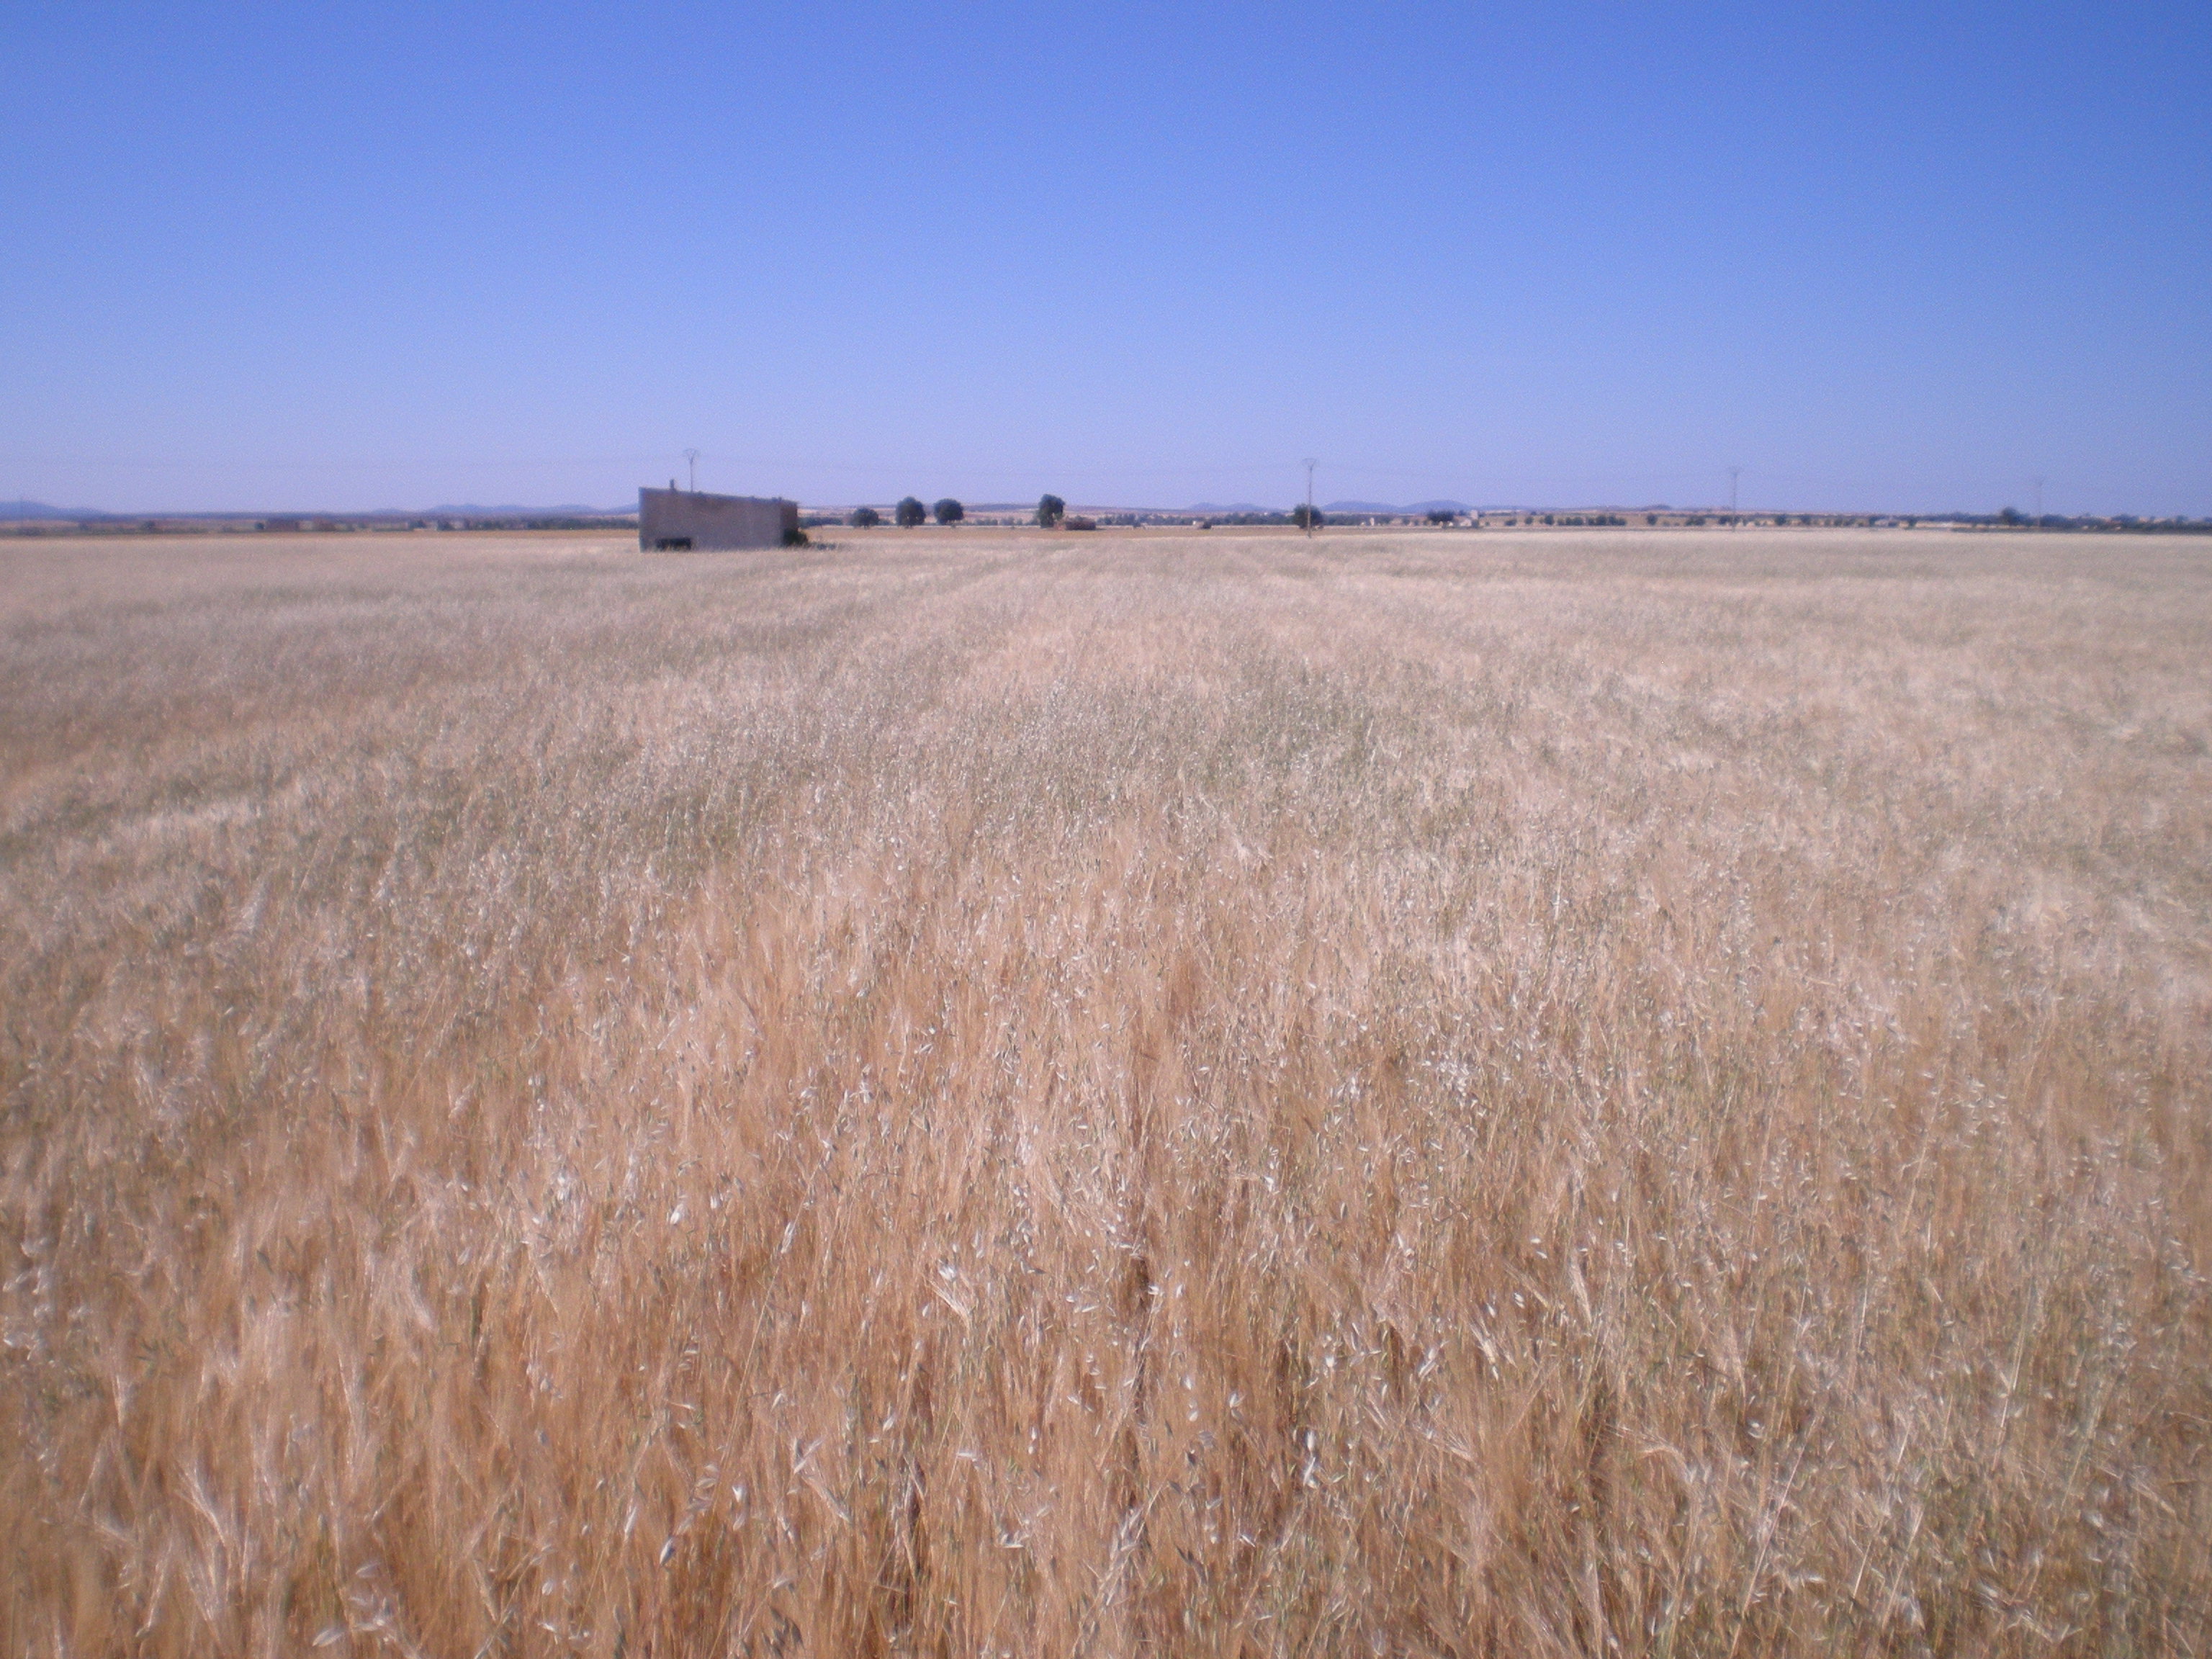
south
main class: Cropland
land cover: Barley
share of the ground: > 75 %
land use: Agriculture (excluding fallow land and kitchen gardens)
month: May
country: ES
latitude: 39.1071
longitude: -3.2554
